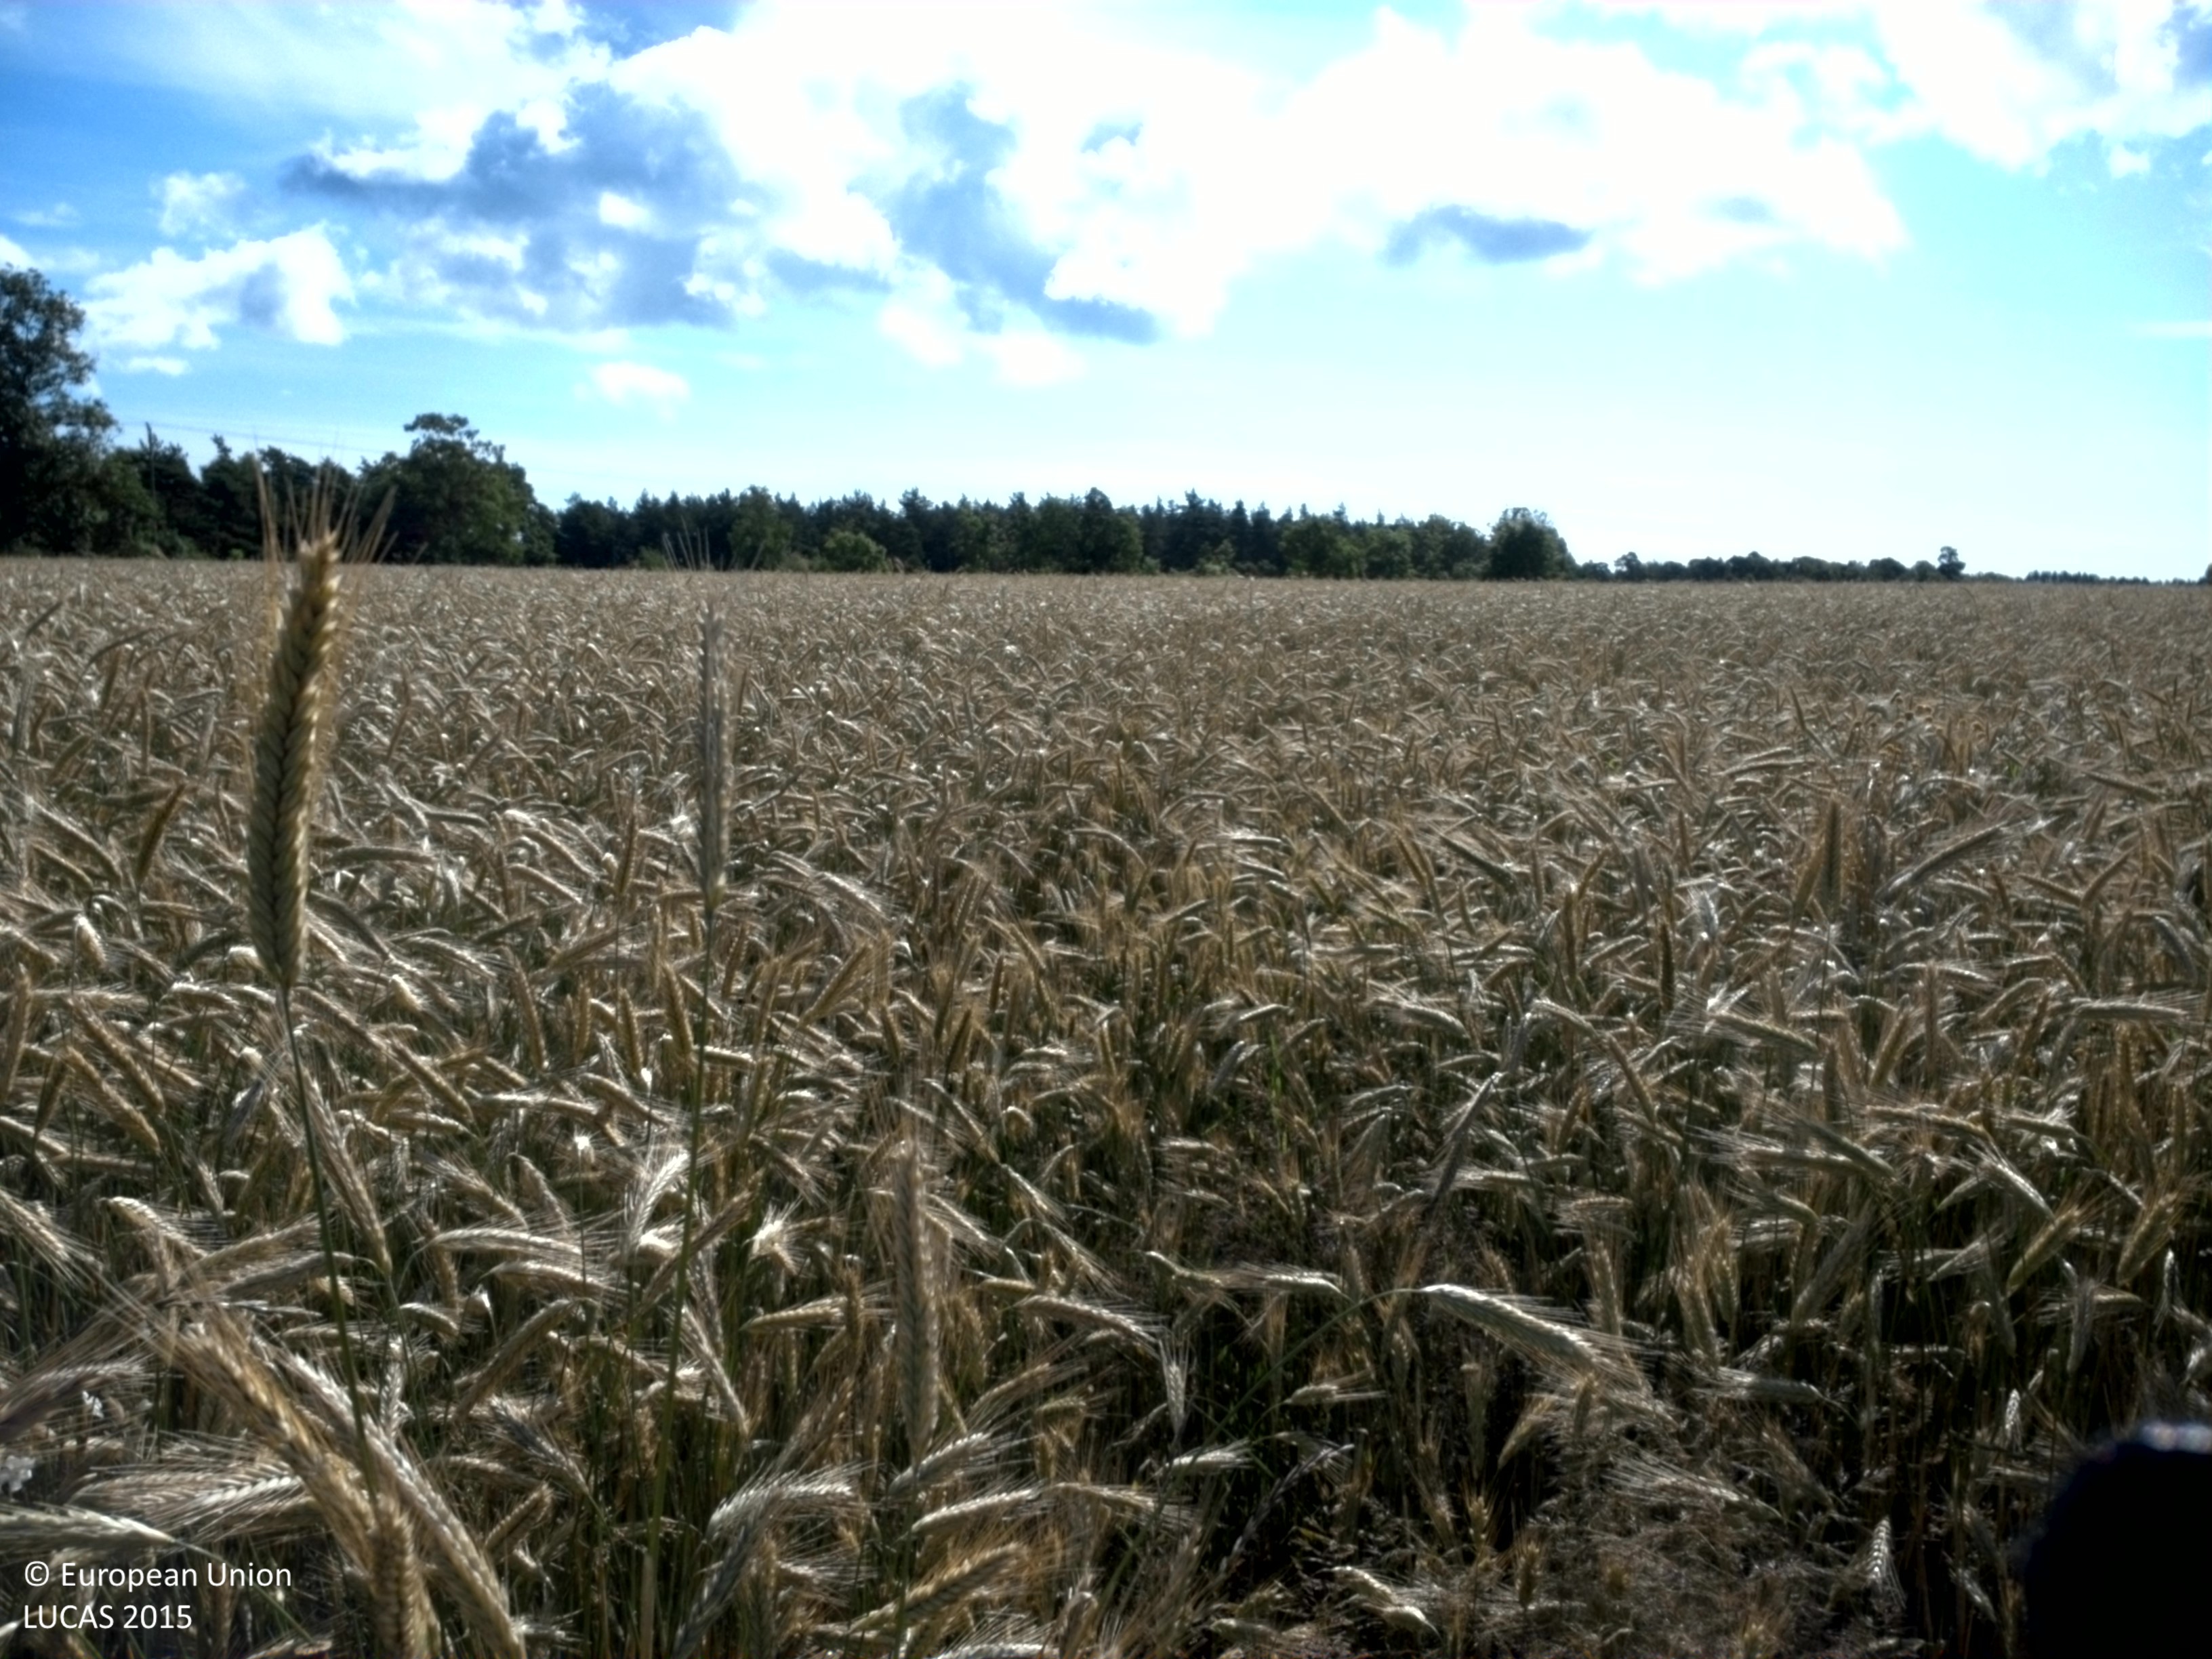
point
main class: Cropland
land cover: Rye
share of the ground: > 75 %
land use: Agriculture (excluding fallow land and kitchen gardens)
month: July
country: SE
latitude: 57.3106
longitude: 18.5928
